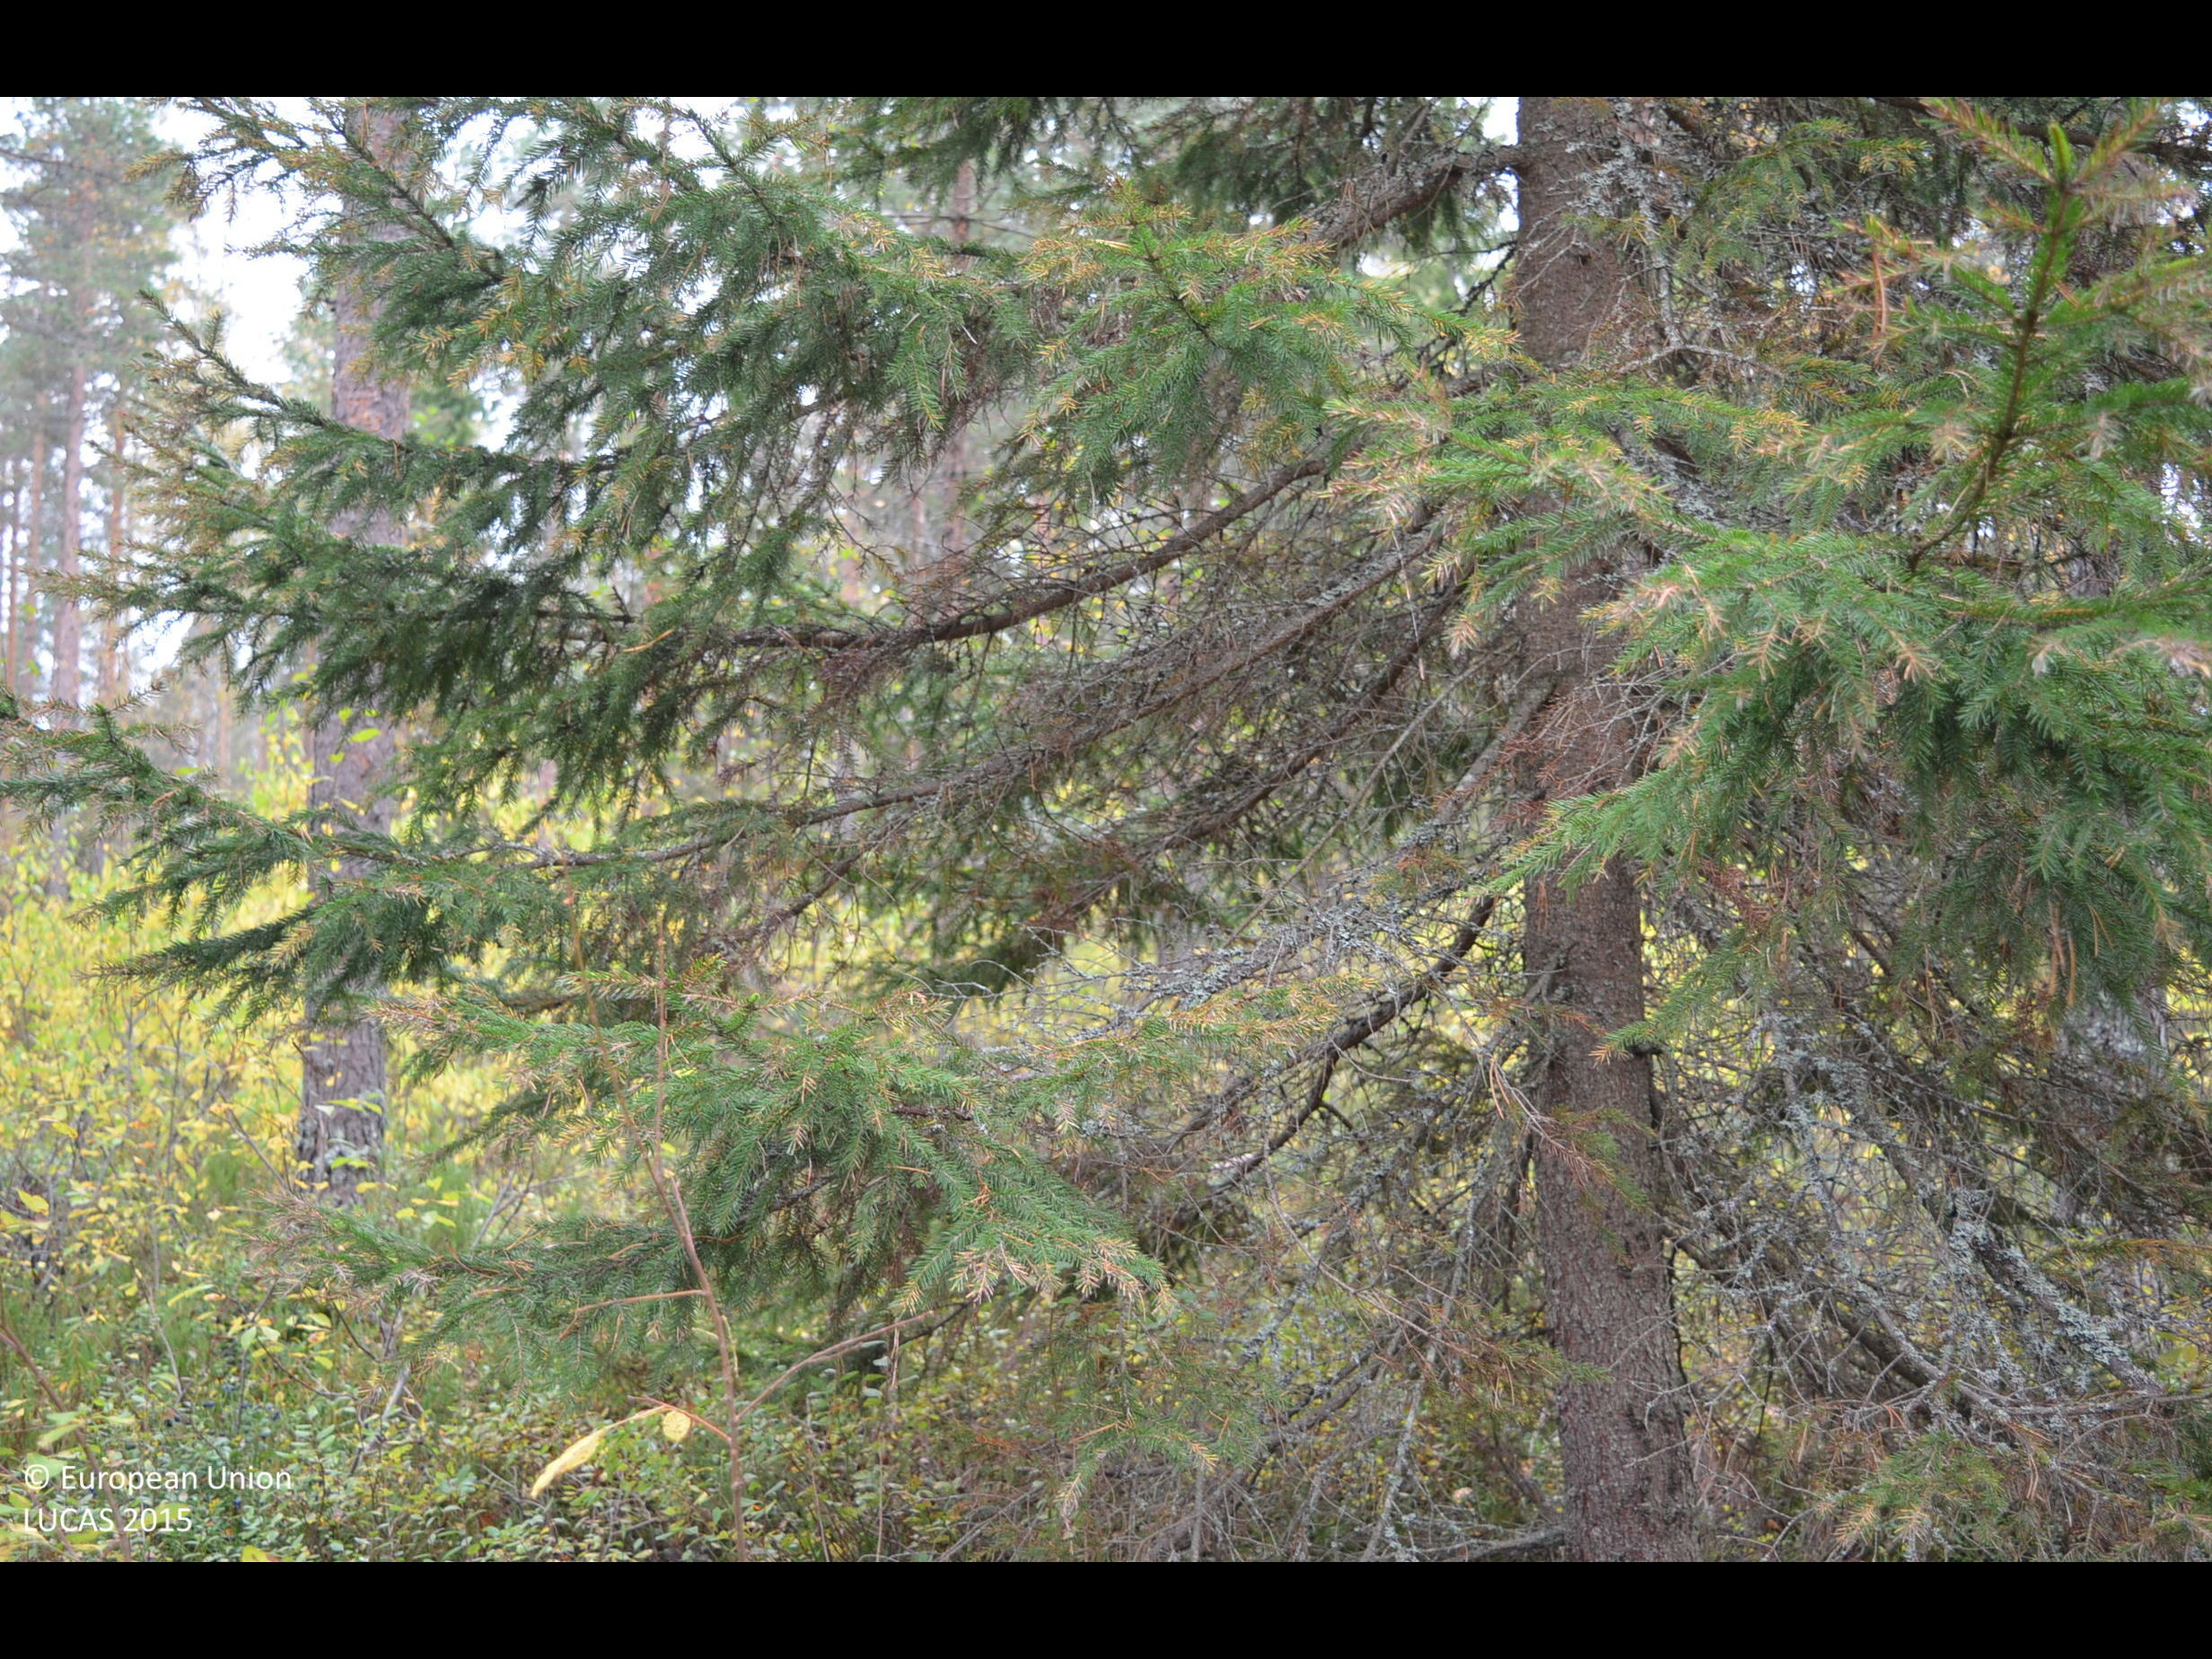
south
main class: Woodland
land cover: Pine dominated mixed woodland
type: boreal forest
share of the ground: 50 - 75 %
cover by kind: coniferous forest trees 40 %, shrubs 35 %, broadleaved forest trees 25 %
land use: Forestry
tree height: > 5 m
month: September
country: FI
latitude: 62.7621
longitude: 23.8028
